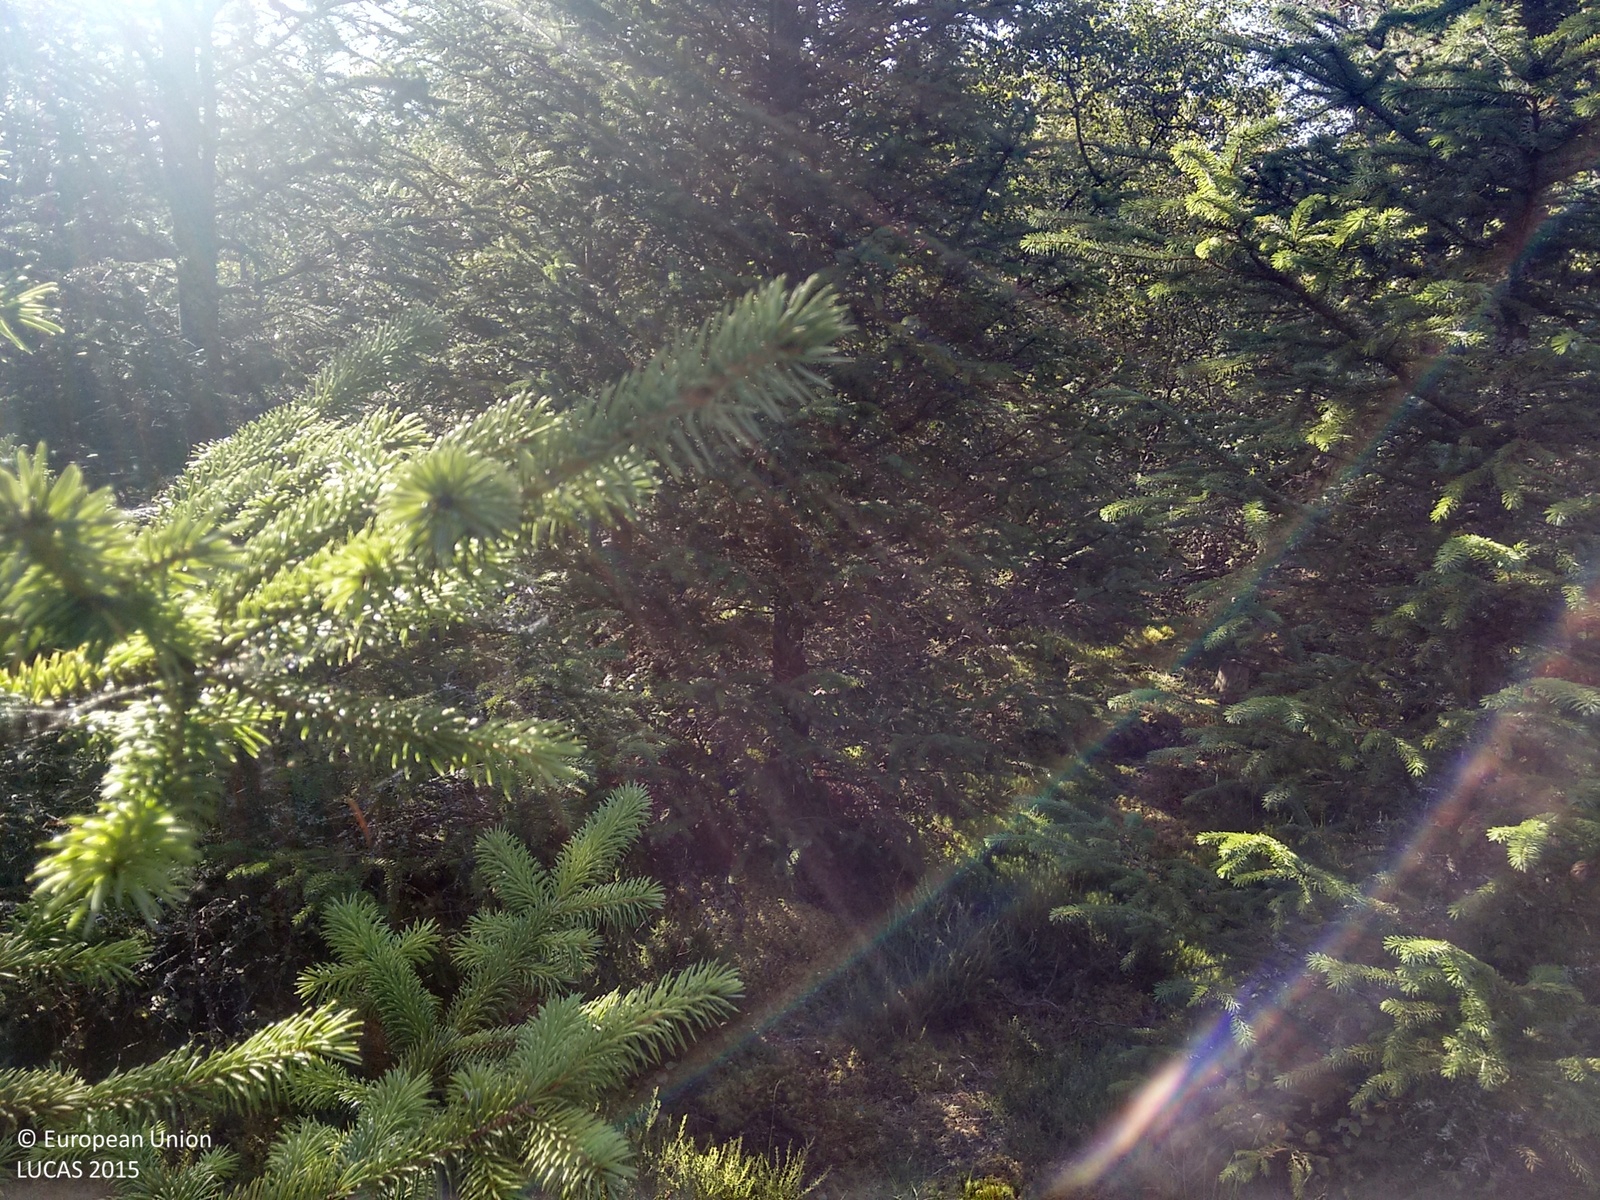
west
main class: Woodland
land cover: Spruce dominated mixed woodland
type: exotic forest
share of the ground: > 75 %
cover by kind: coniferous forest trees 65 %, broadleaved forest trees 30 %, lichens and mosses 5 %
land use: Forestry
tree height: > 5 m
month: September
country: GB
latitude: 57.4490
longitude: -3.7907
